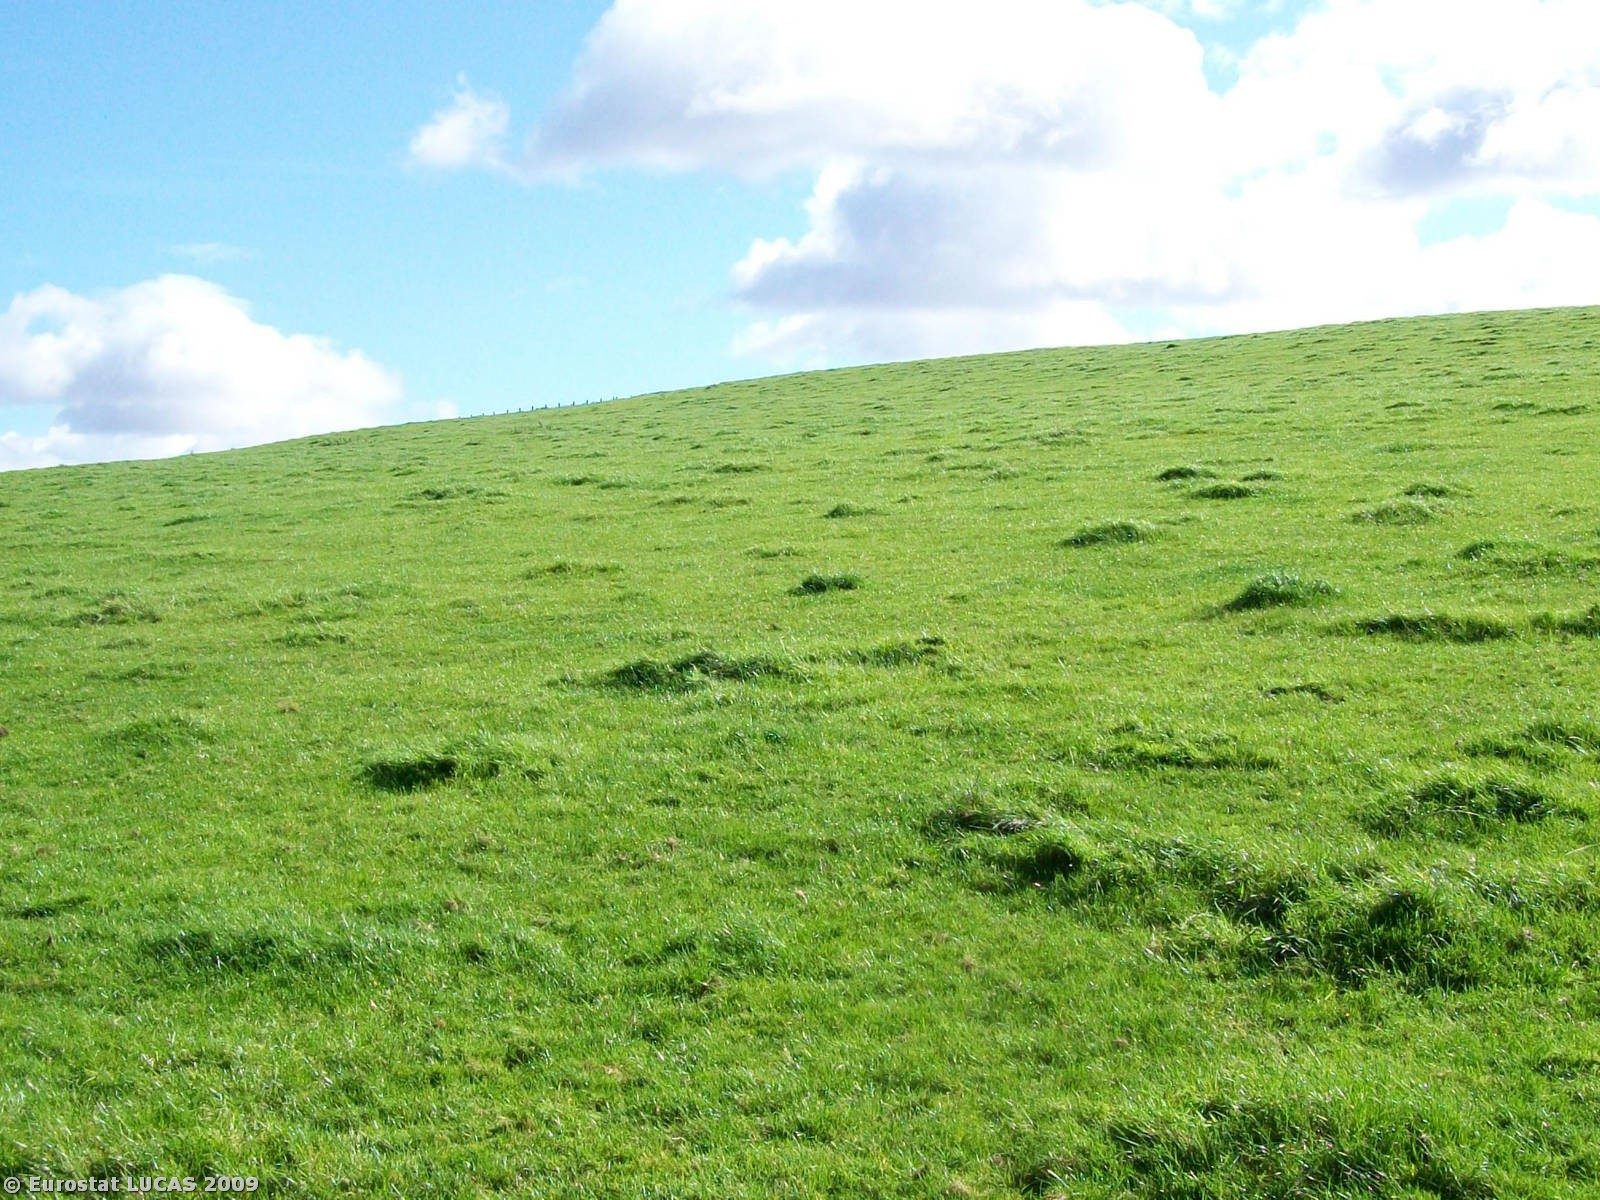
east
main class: Grassland
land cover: Grassland without tree/shrub cover
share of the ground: > 75 %
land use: Agriculture (excluding fallow land and kitchen gardens)
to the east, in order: Grassland without tree/shrub cover; Fences; Grass margins; Barley
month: September
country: GB
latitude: 55.6677
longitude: -2.2828
